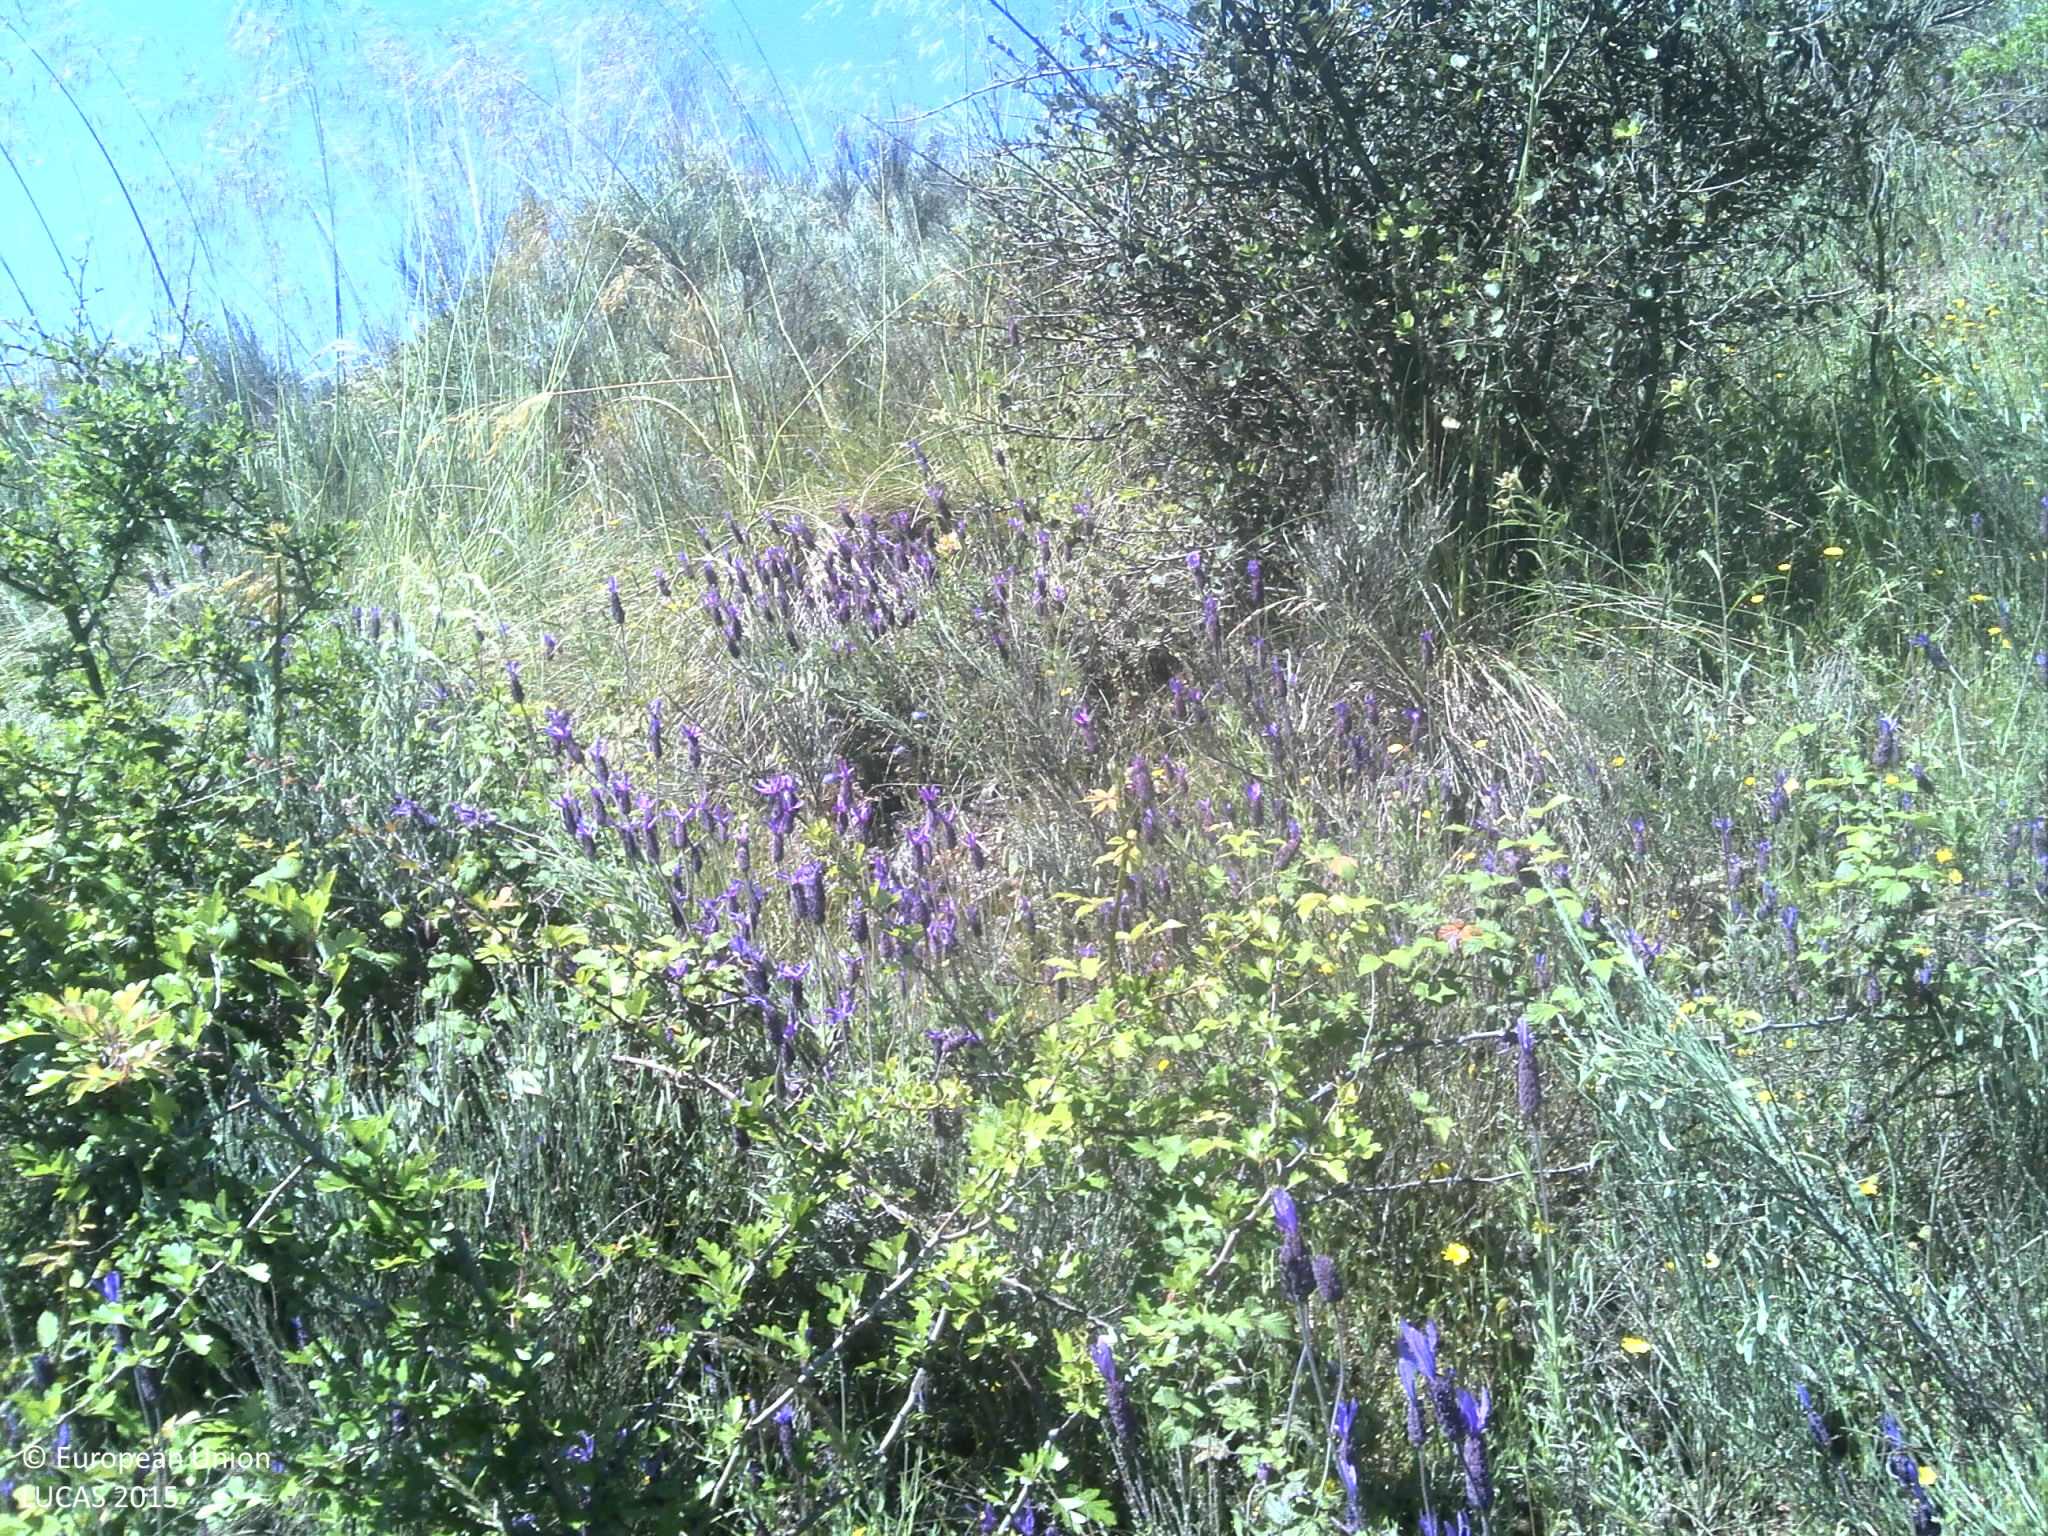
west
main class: Shrubland
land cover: Shrubland without tree cover
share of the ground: 50 - 75 %
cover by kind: shrubs 75 %, herbaceous plants 15 %, unconsolidated bare surface 10 %
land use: Abandoned areas
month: May
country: PT
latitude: 40.6730
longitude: -7.2981
